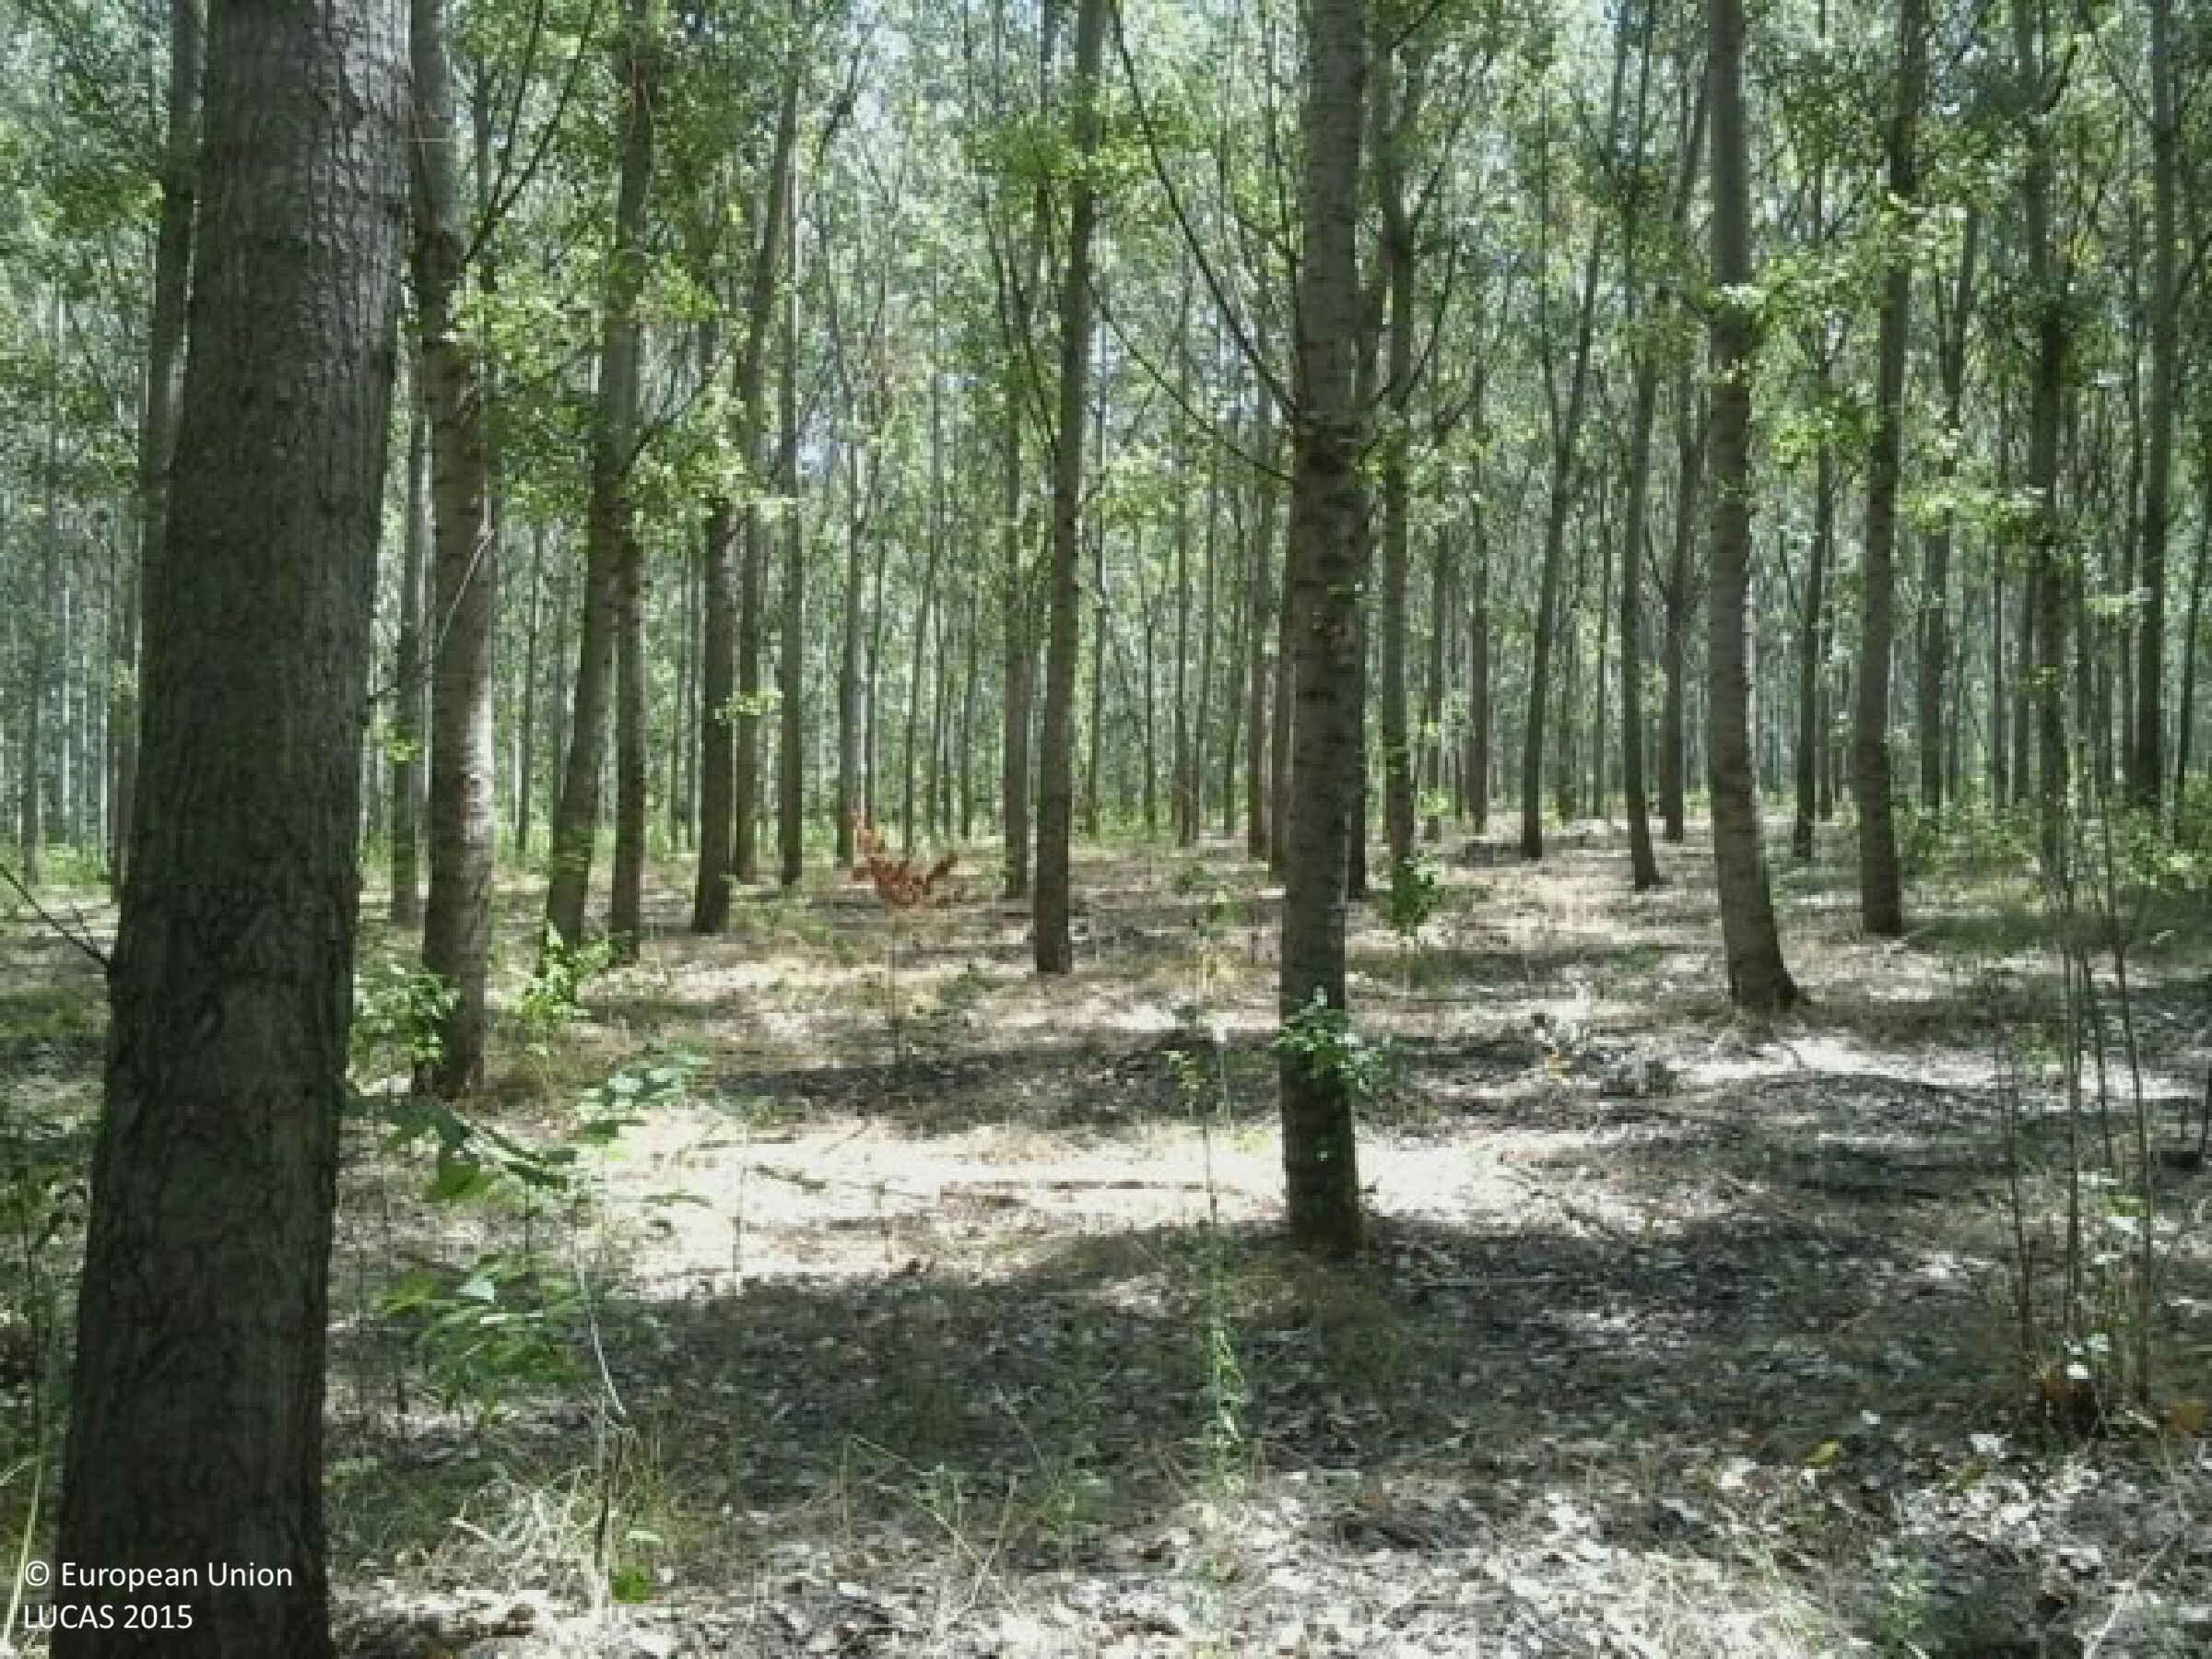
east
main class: Woodland
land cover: Broadleaved woodland
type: mesophytic deciduous forest
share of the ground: > 75 %
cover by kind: broadleaved forest trees 85 %, herbaceous plants 10 %, shrubs 5 %
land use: Forestry
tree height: > 5 m
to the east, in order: Broadleaved woodland; Grassland with sparse tree/shrub cover; Electric lines; Grassland with sparse tree/shrub cover; Broadleaved woodland
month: August
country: HU
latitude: 46.9843
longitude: 19.8434
